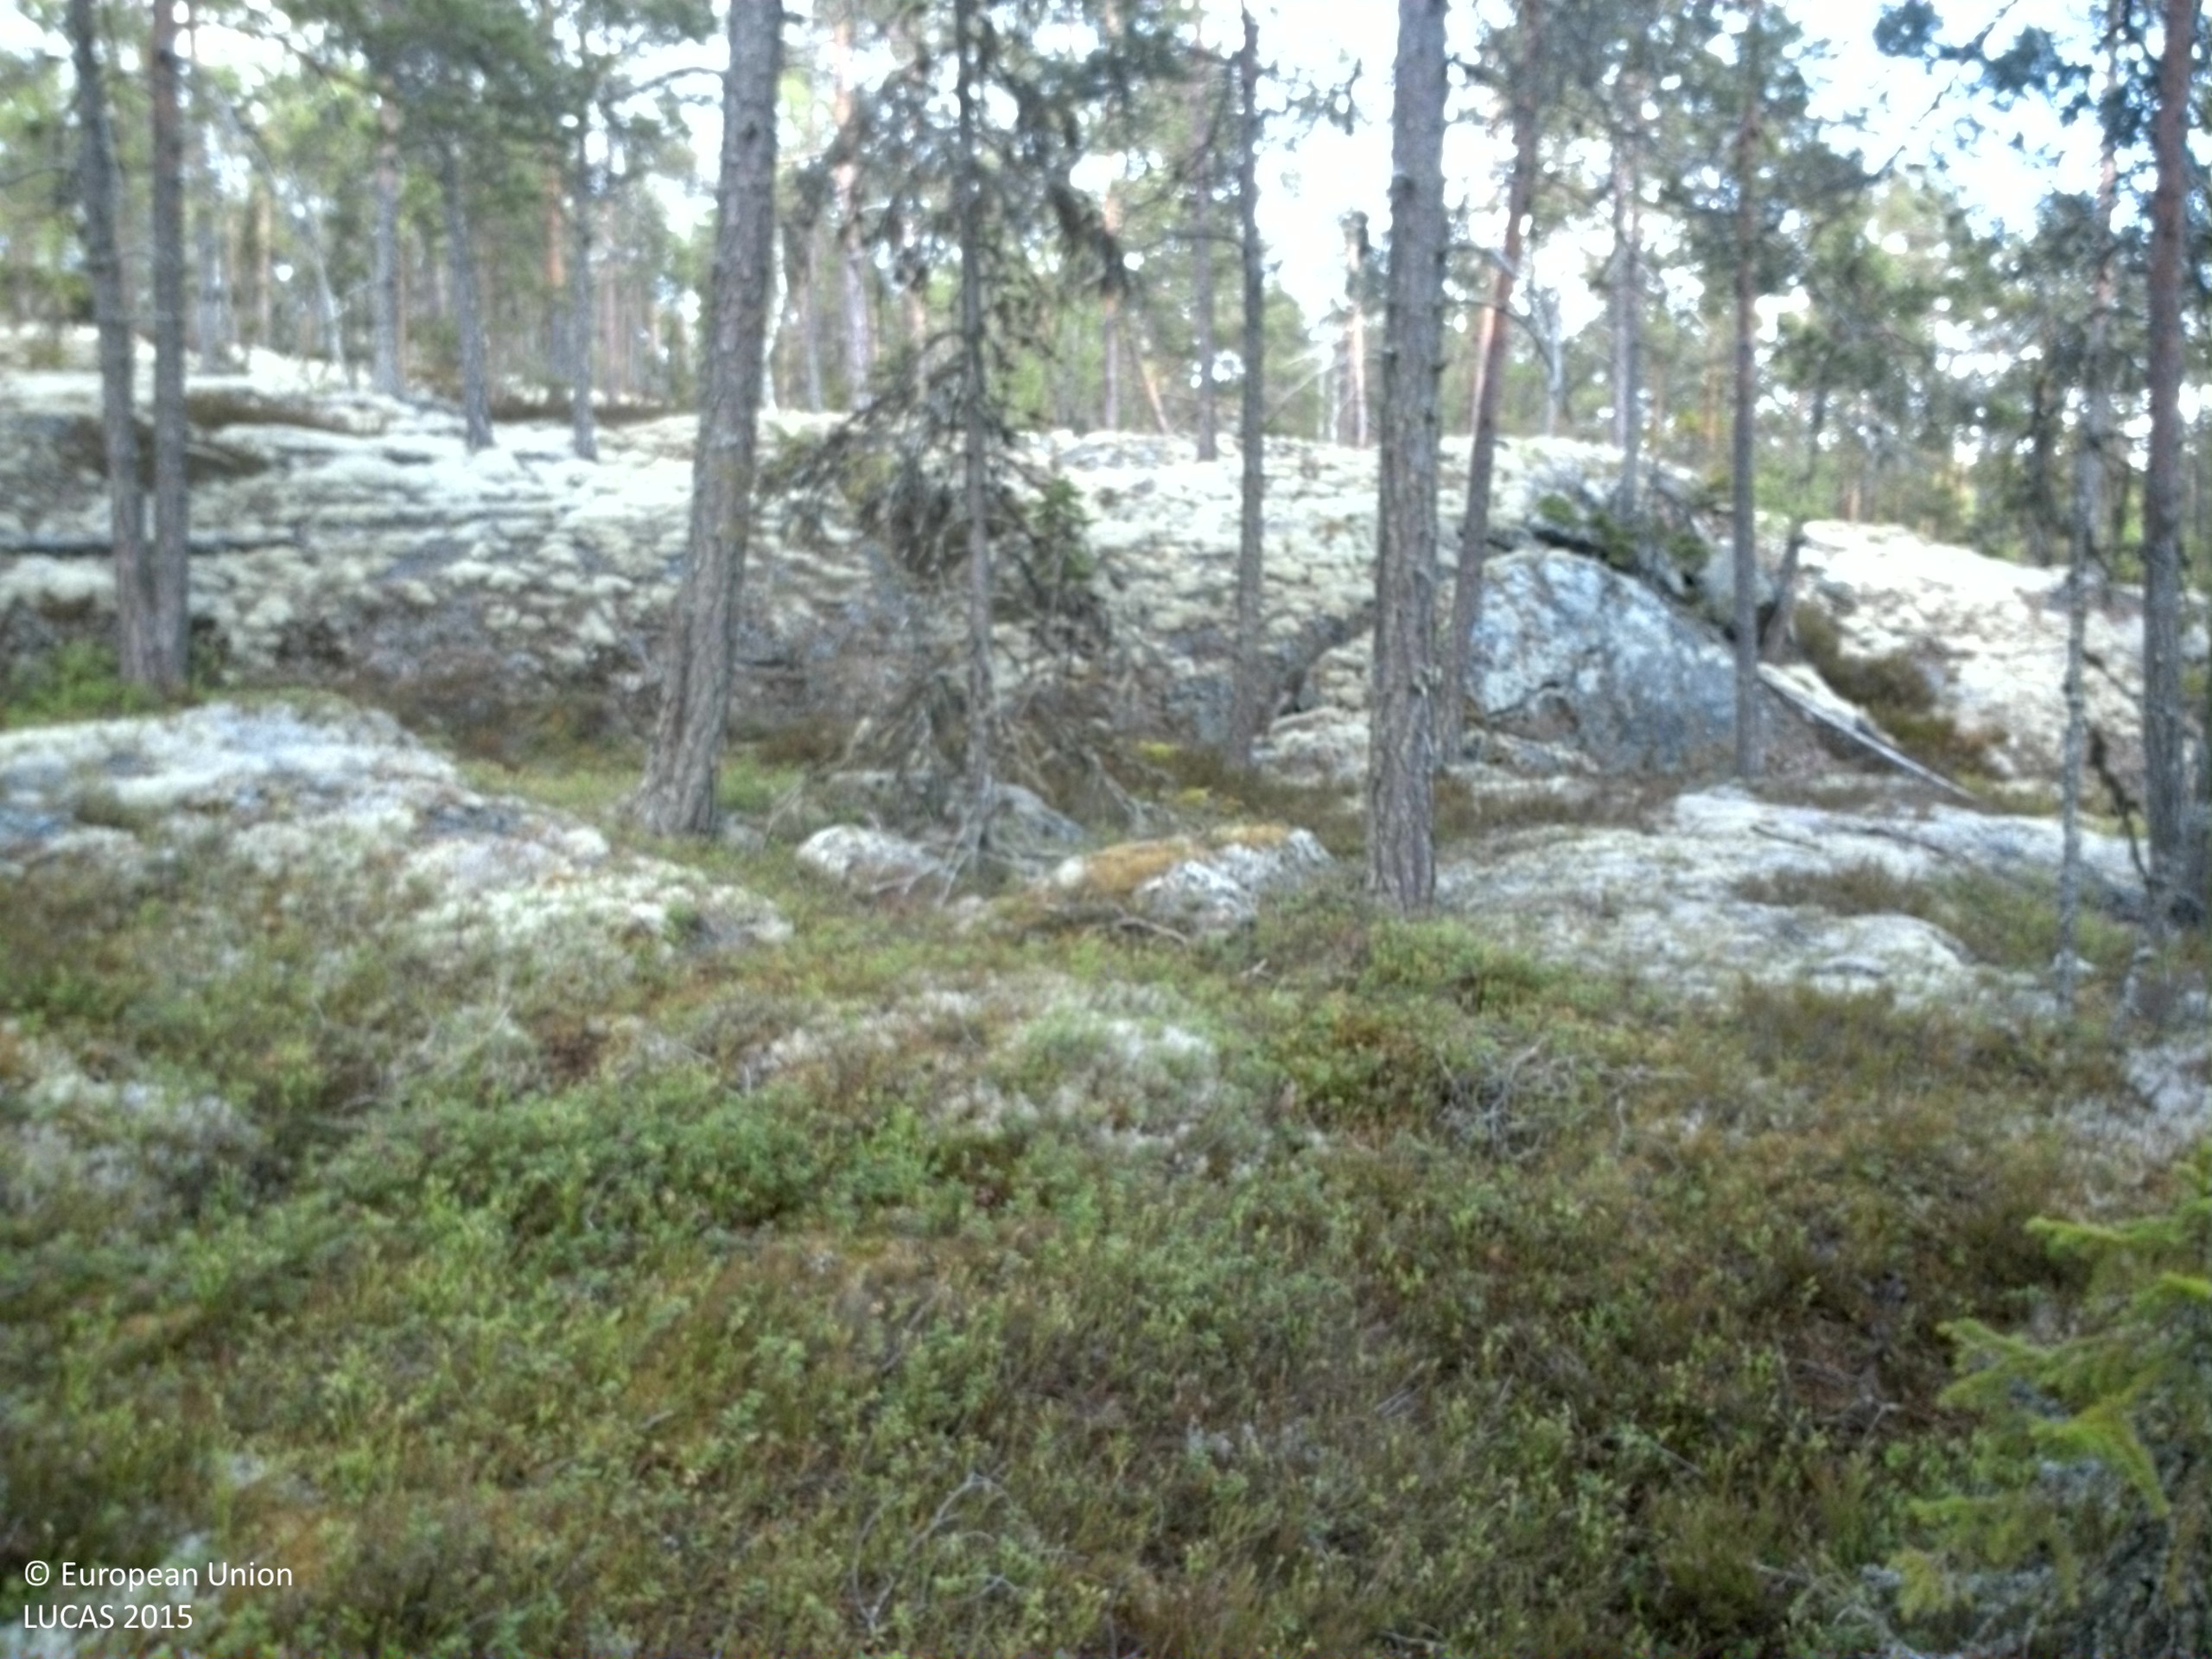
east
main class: Woodland
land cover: Pine dominated coniferous woodland
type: boreal forest
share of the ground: 25 - 50 %
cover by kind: coniferous forest trees 35 %, shrubs 30 %, lichens and mosses 30 %, consolidated bare surface 5 %
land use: Forestry
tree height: > 5 m
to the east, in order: Pine dominated coniferous woodland; Other coniferous woodland
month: May
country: SE
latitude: 63.1170
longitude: 17.8070
